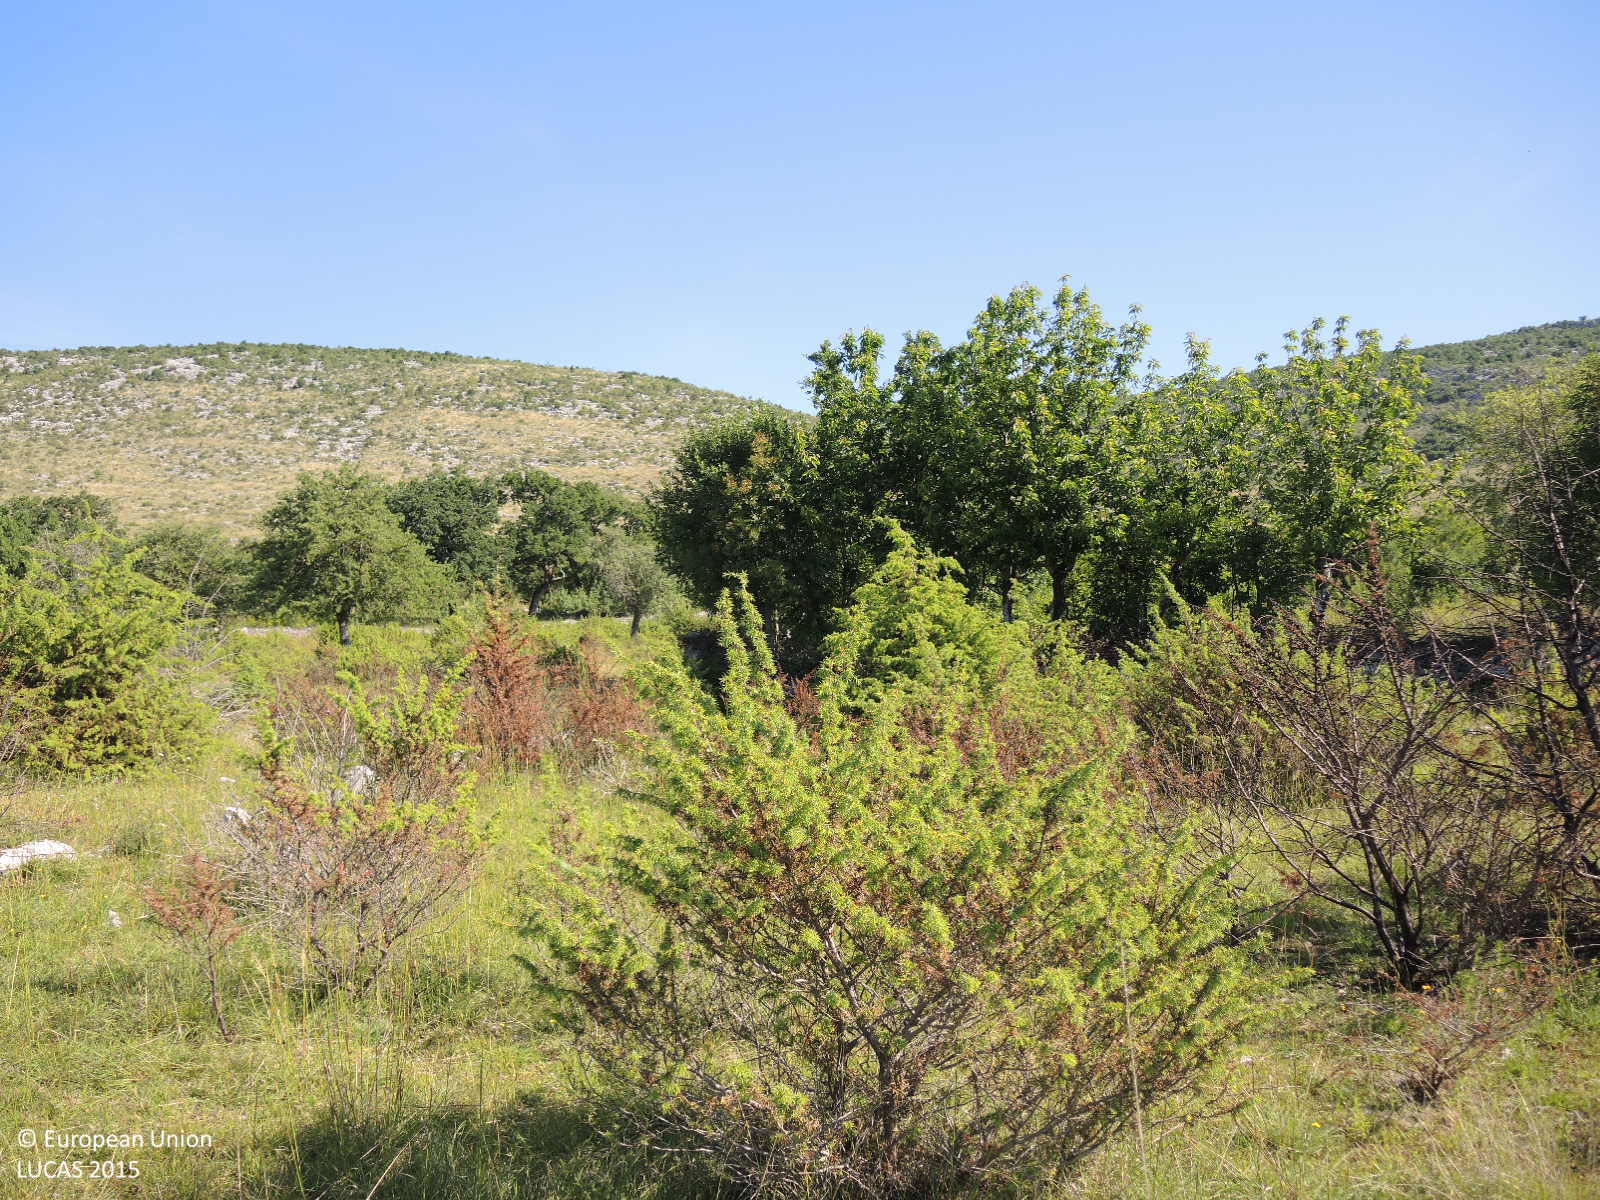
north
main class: Shrubland
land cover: Shrubland with sparse tree cover
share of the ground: 25 - 50 %
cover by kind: herbaceous plants 45 %, shrubs 40 %, broadleaved forest trees 5 %, consolidated bare surface 5 %, unconsolidated bare surface 5 %
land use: Semi-natural and natural areas not in use
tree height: < 5 m
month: June
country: HR
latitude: 43.6419
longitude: 16.1769
